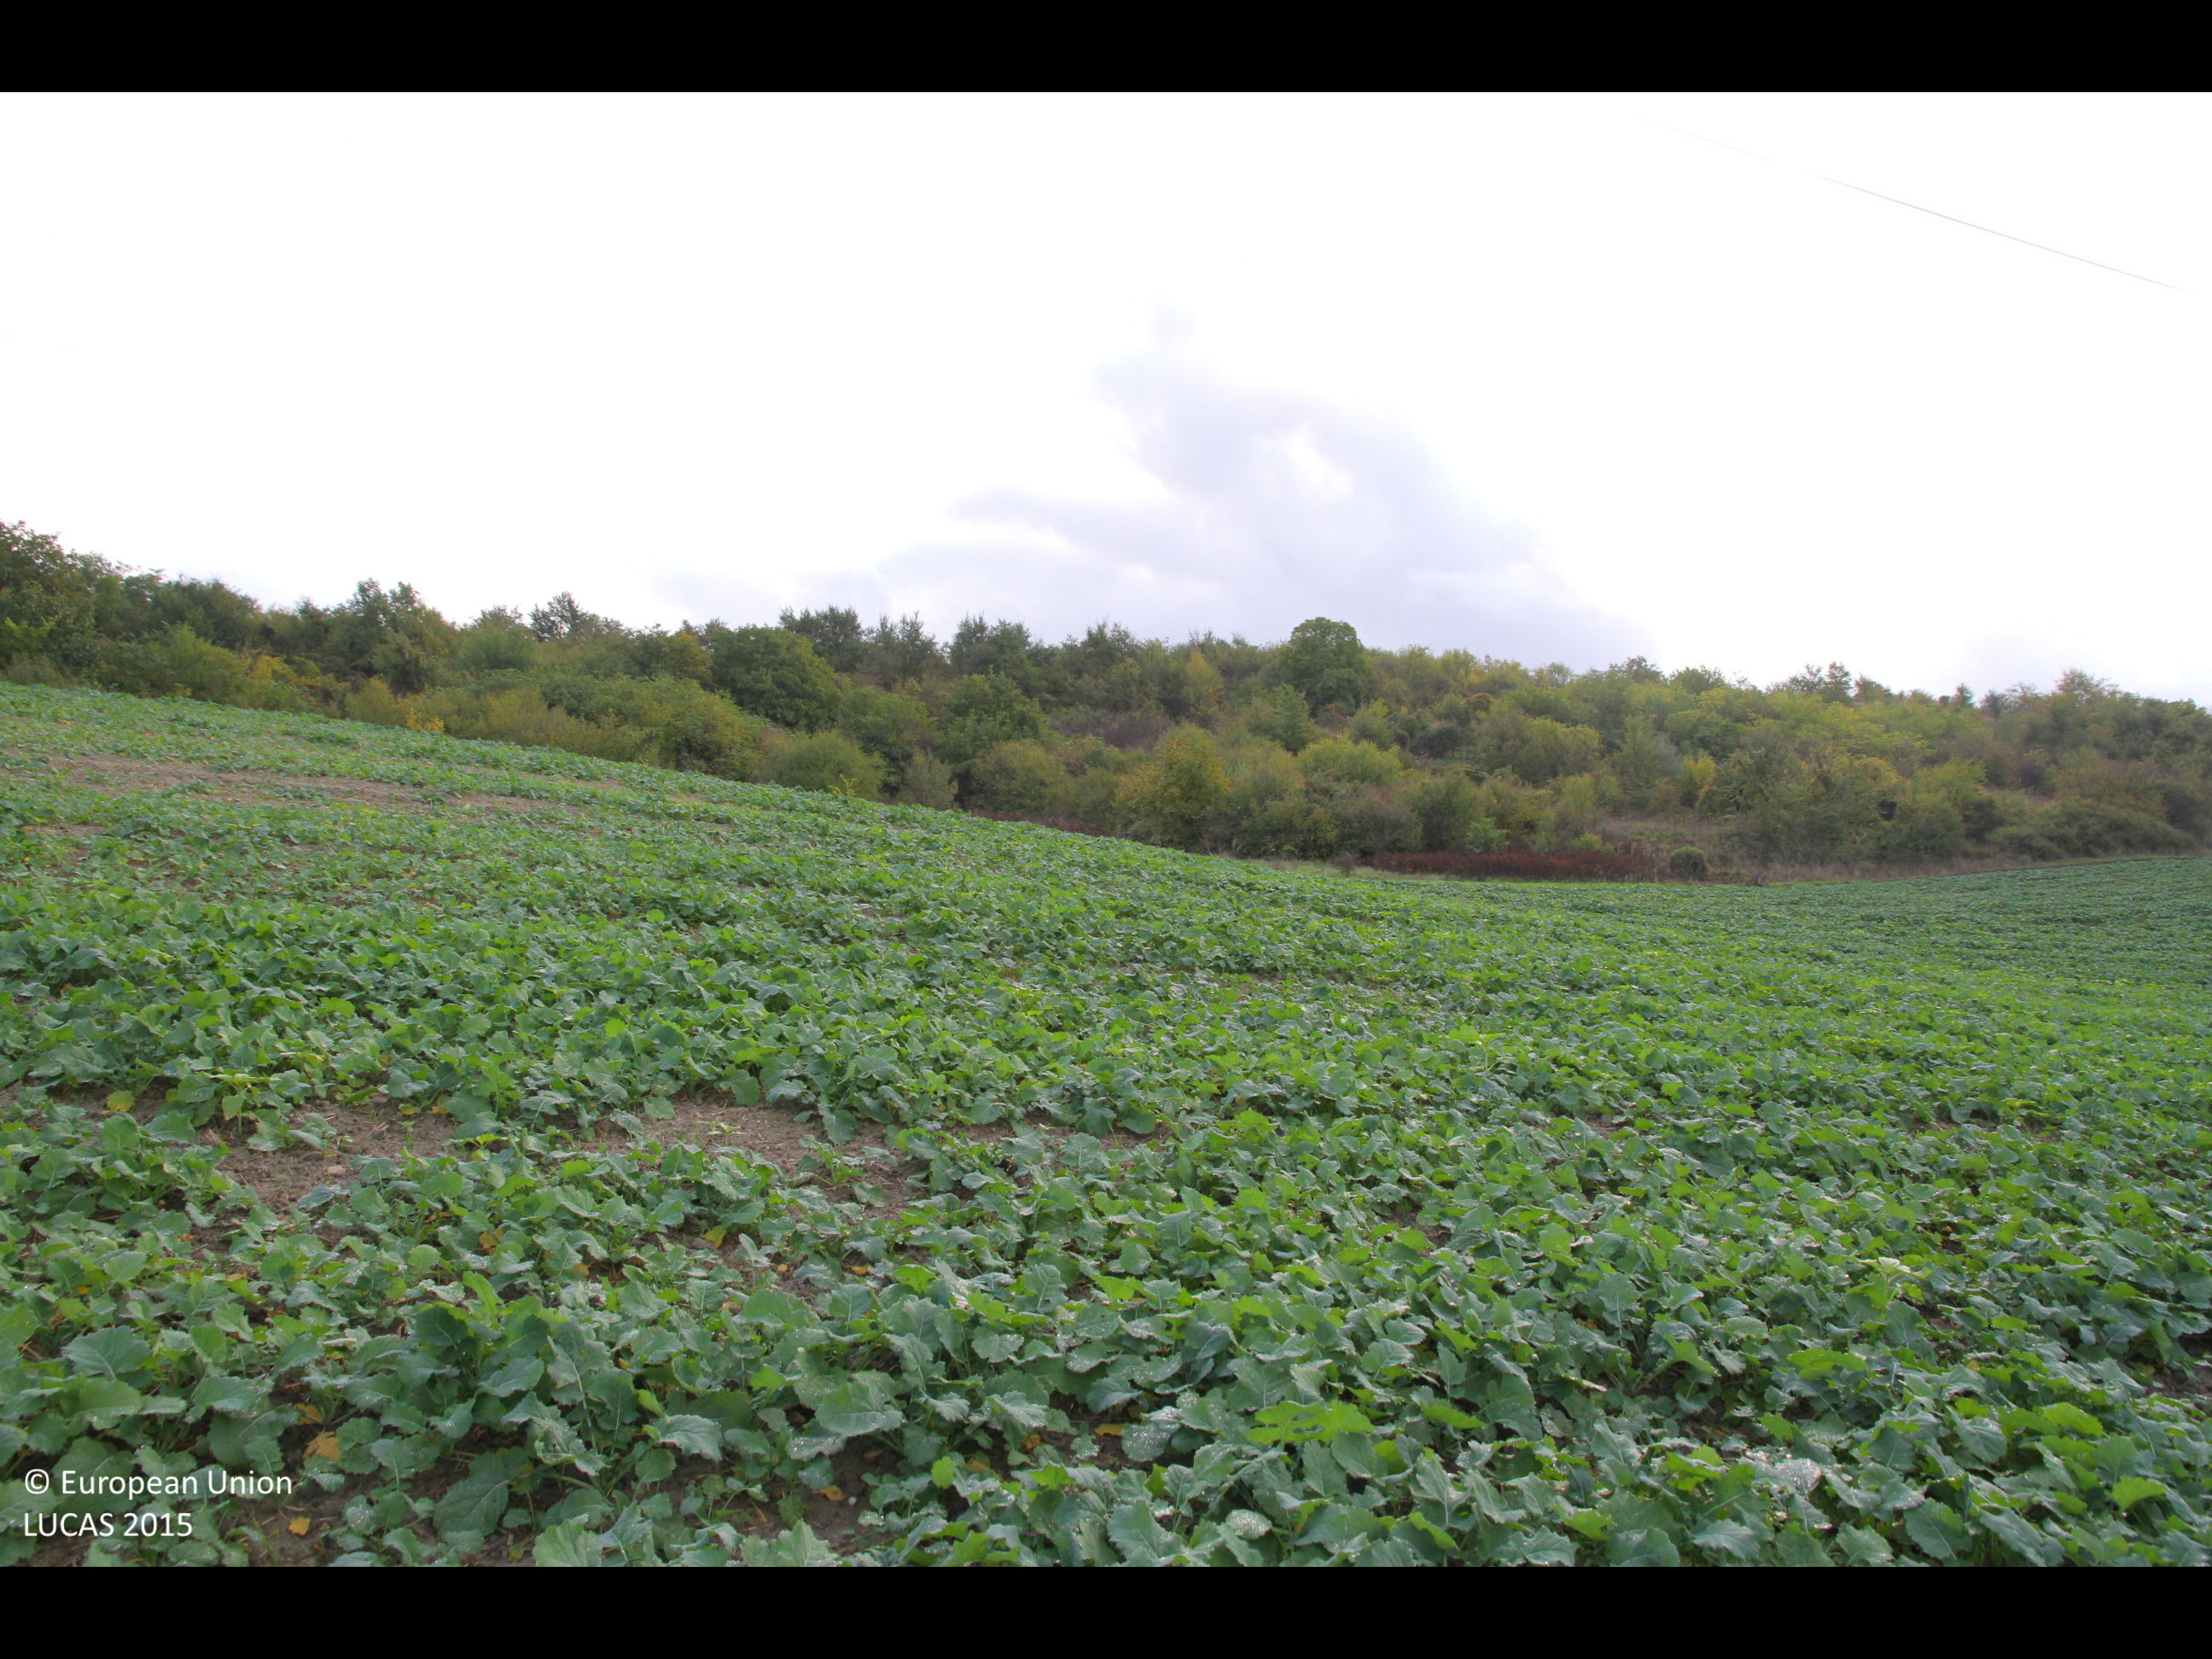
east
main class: Cropland
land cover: Rape and turnip rape
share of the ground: > 75 %
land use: Agriculture (excluding fallow land and kitchen gardens)
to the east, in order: Rape and turnip rape; Electric lines; Rape and turnip rape; Grass margins; Tracks; Shrubland with sparse tree cover; Broadleaved woodland; Shrubland with sparse tree cover; Tracks; Common wheat
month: October
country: BG
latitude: 43.2265
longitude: 27.0190
